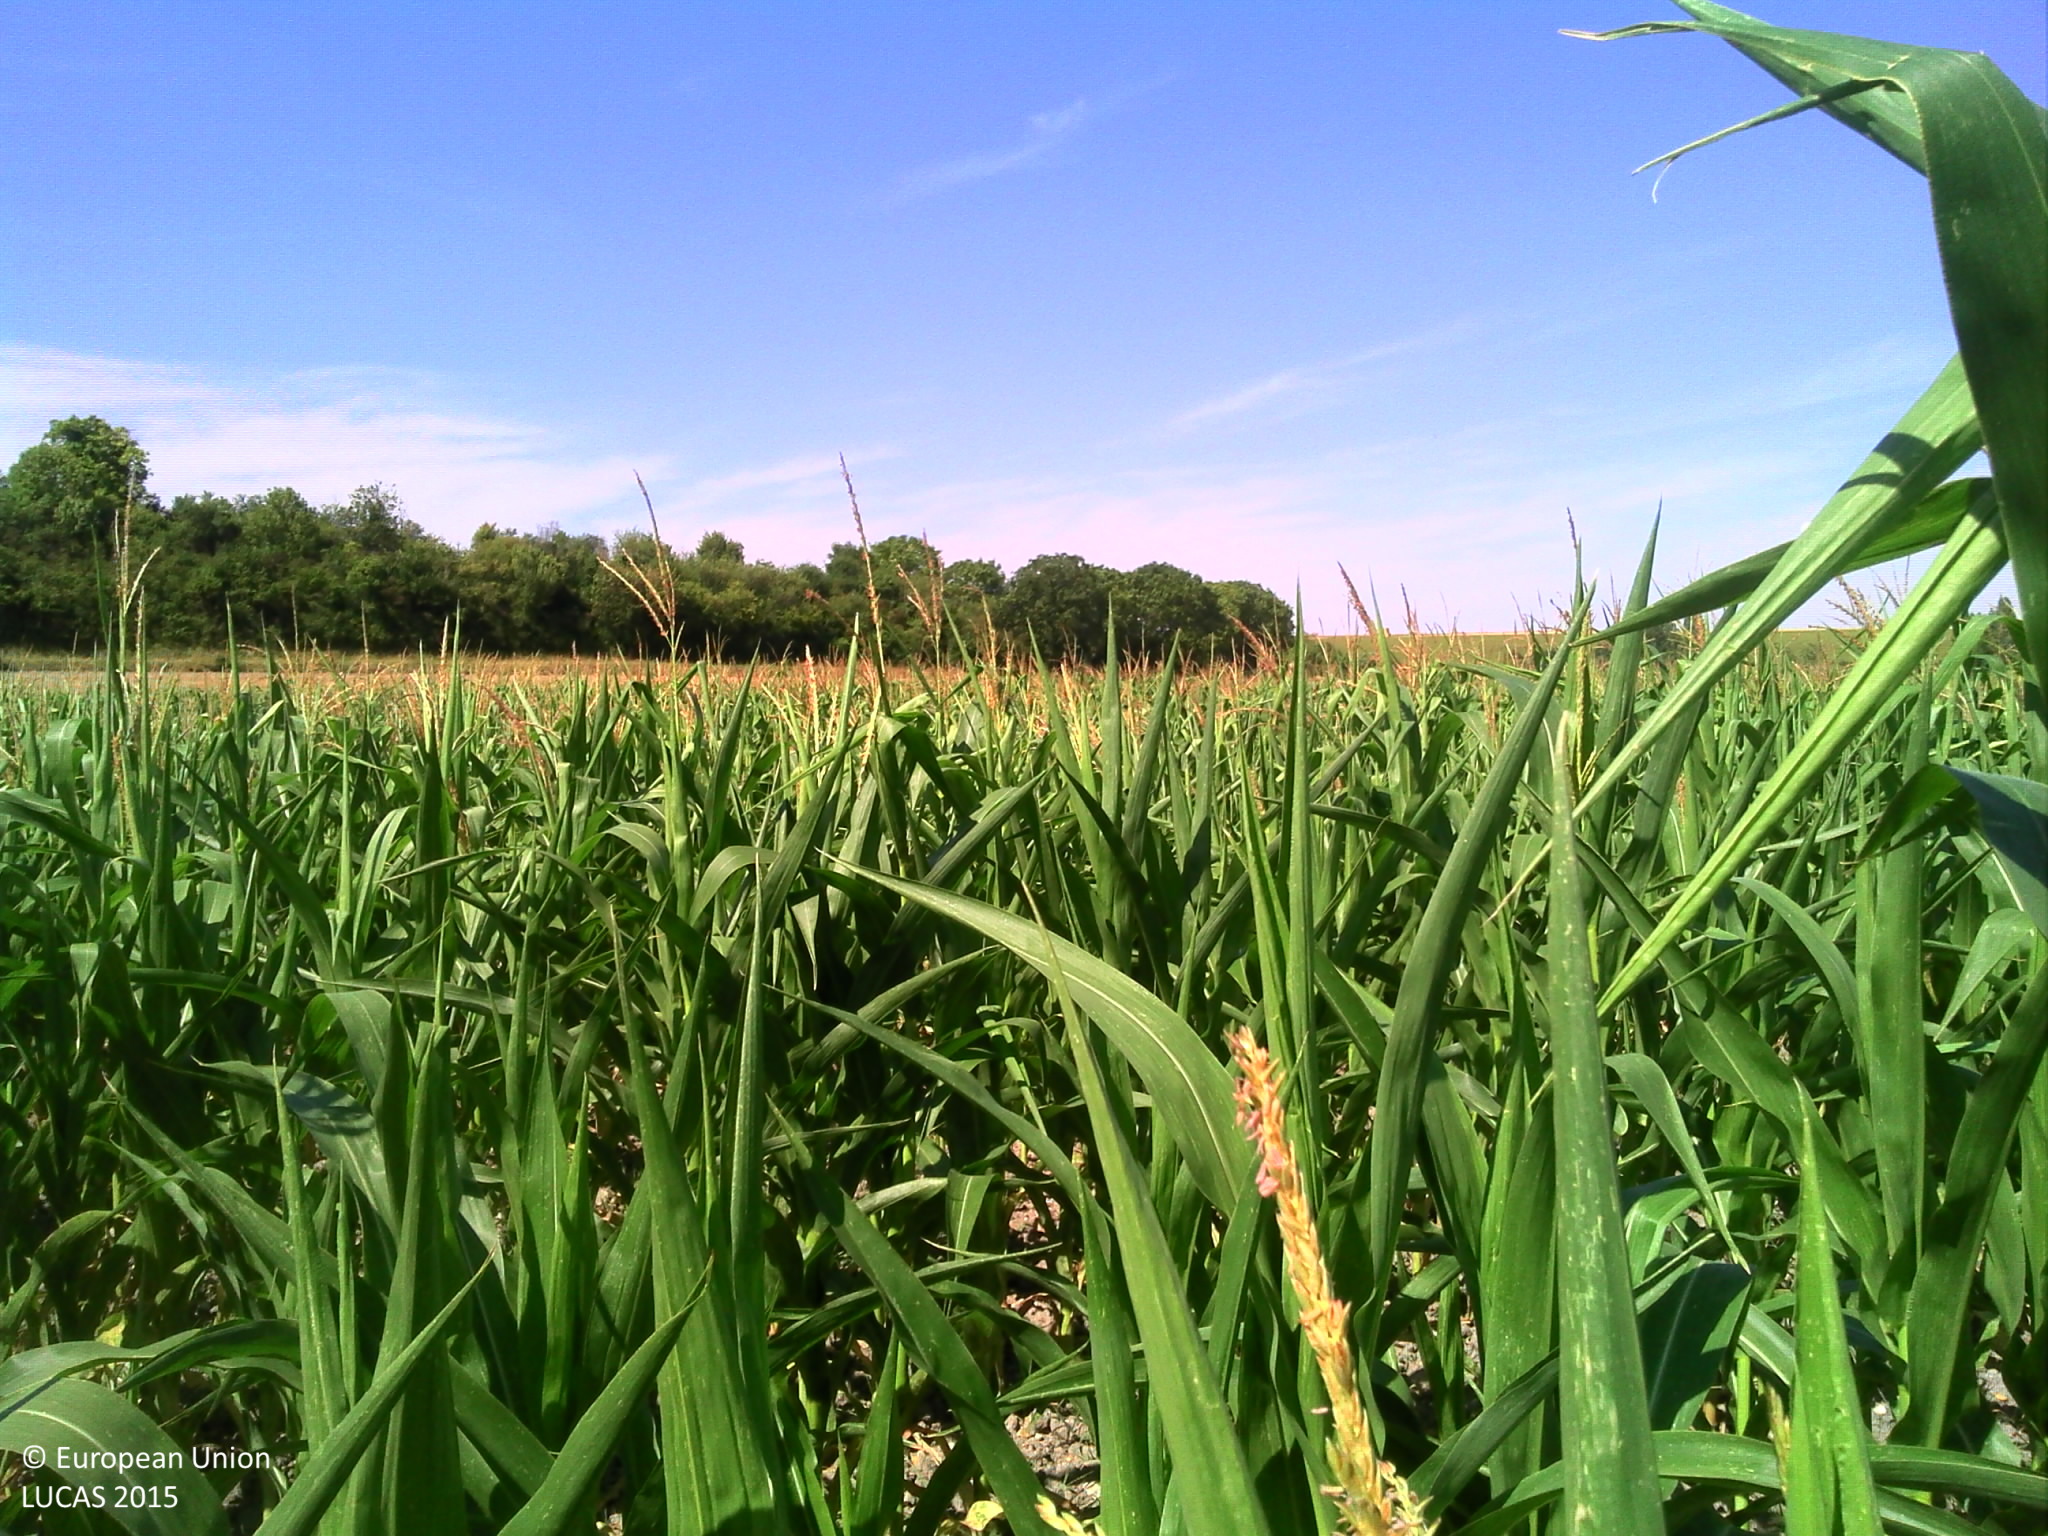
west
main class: Cropland
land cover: Maize
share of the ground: > 75 %
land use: Agriculture (excluding fallow land and kitchen gardens)
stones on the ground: < 10 %
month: July
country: FR
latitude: 47.1016
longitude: 0.4534
